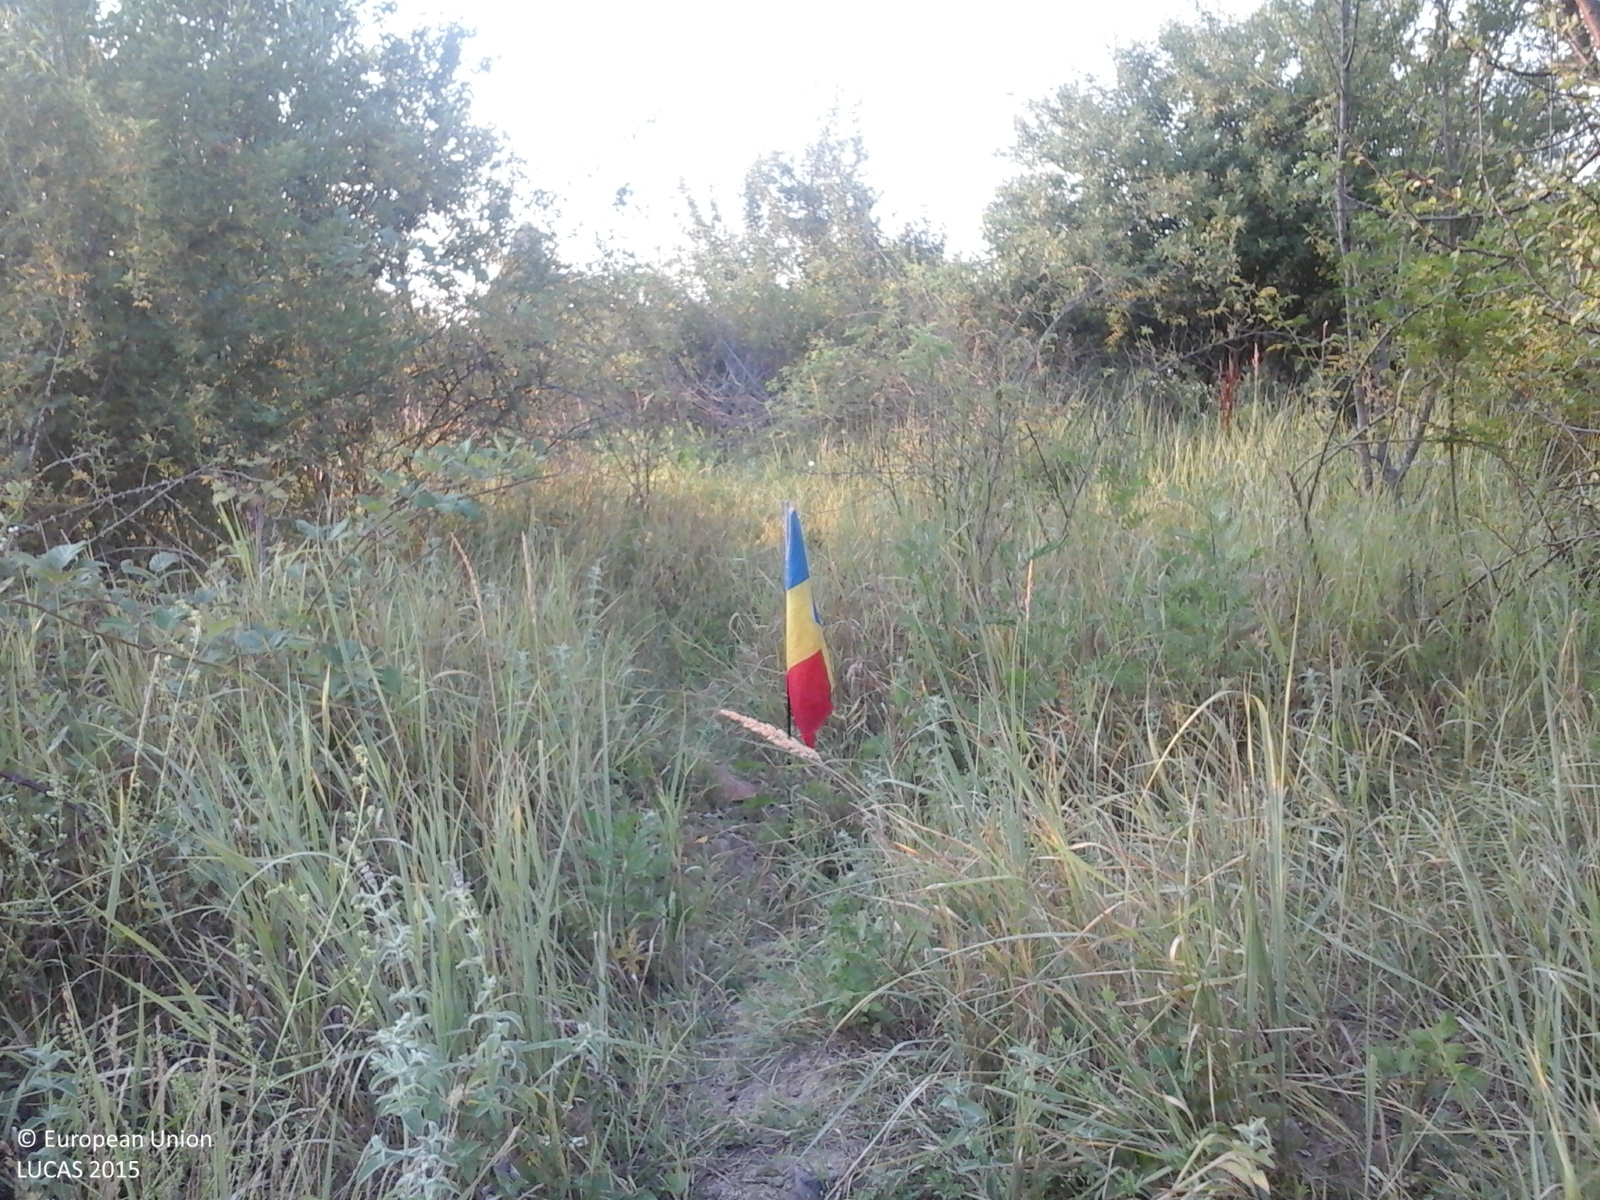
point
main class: Shrubland
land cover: Shrubland with sparse tree cover
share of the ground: > 75 %
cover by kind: shrubs 95 %, broadleaved forest trees 5 %
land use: Abandoned areas
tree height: > 5 m
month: July
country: RO
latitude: 44.8055
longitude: 25.4034
